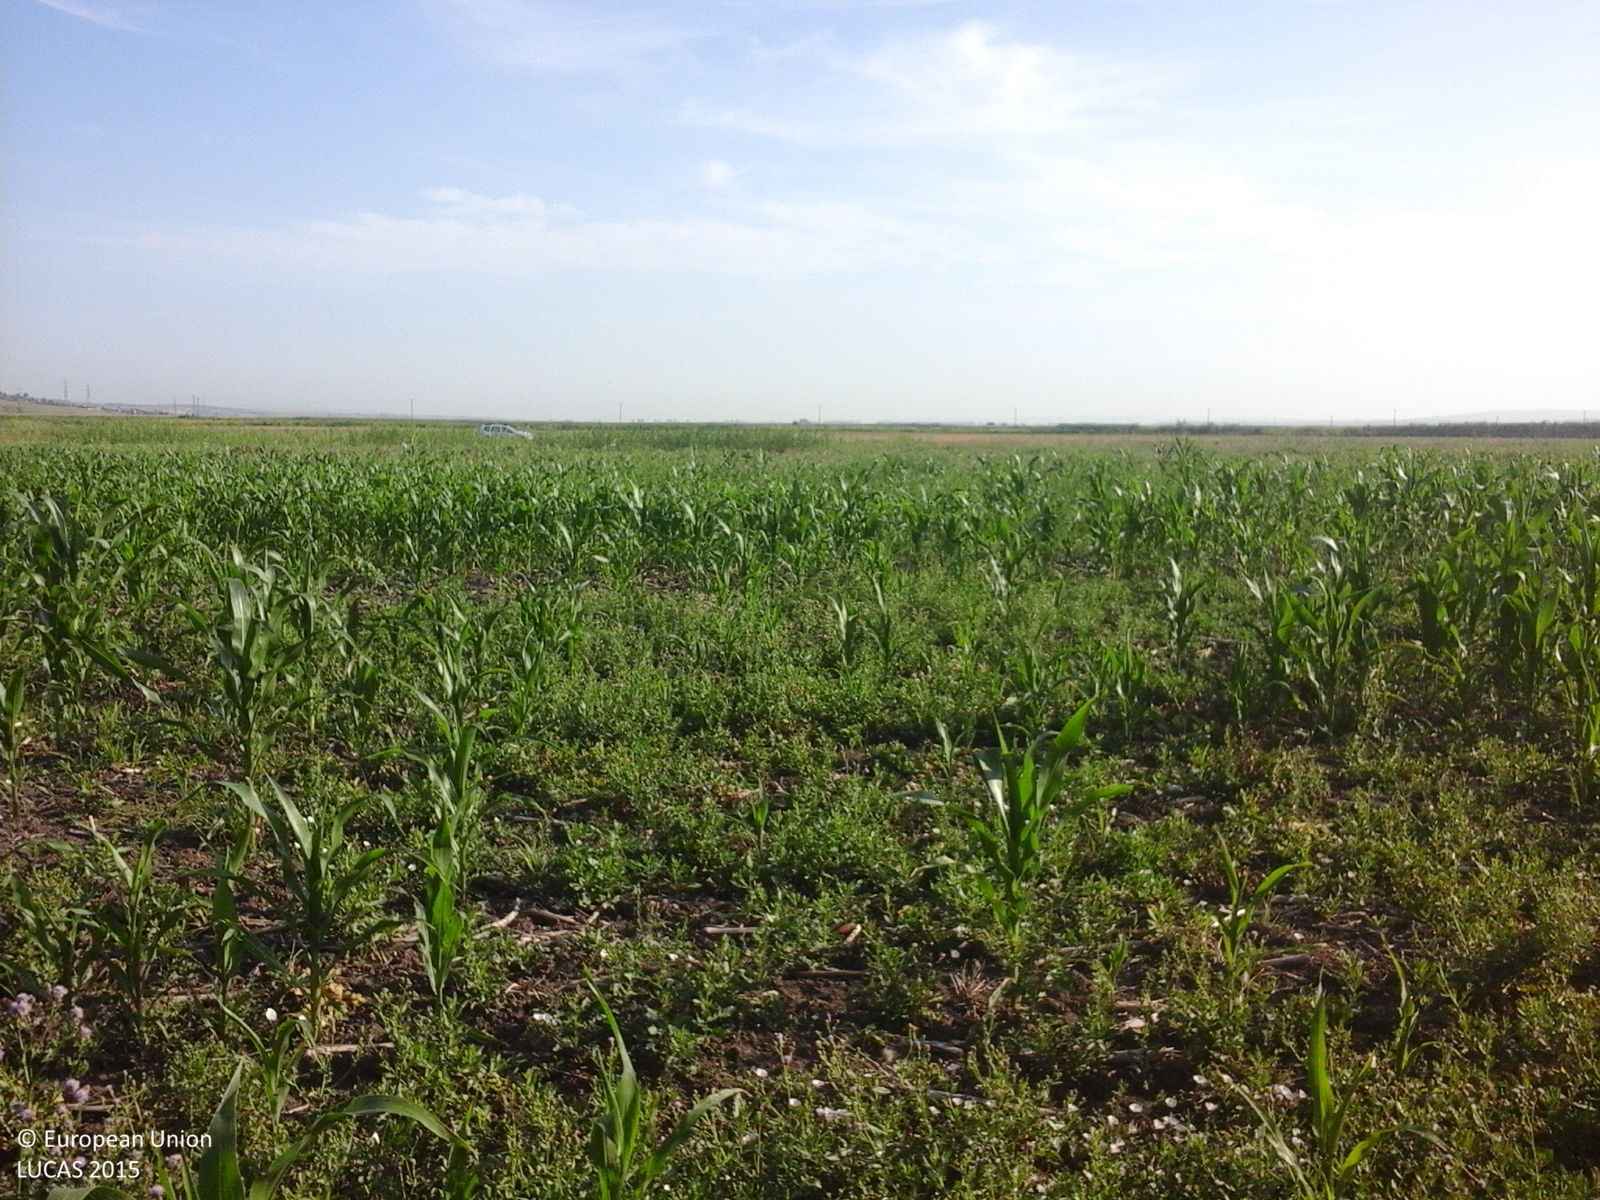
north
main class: Cropland
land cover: Maize
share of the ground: 50 - 75 %
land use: Agriculture (excluding fallow land and kitchen gardens)
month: July
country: RO
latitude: 46.5096
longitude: 28.1825
